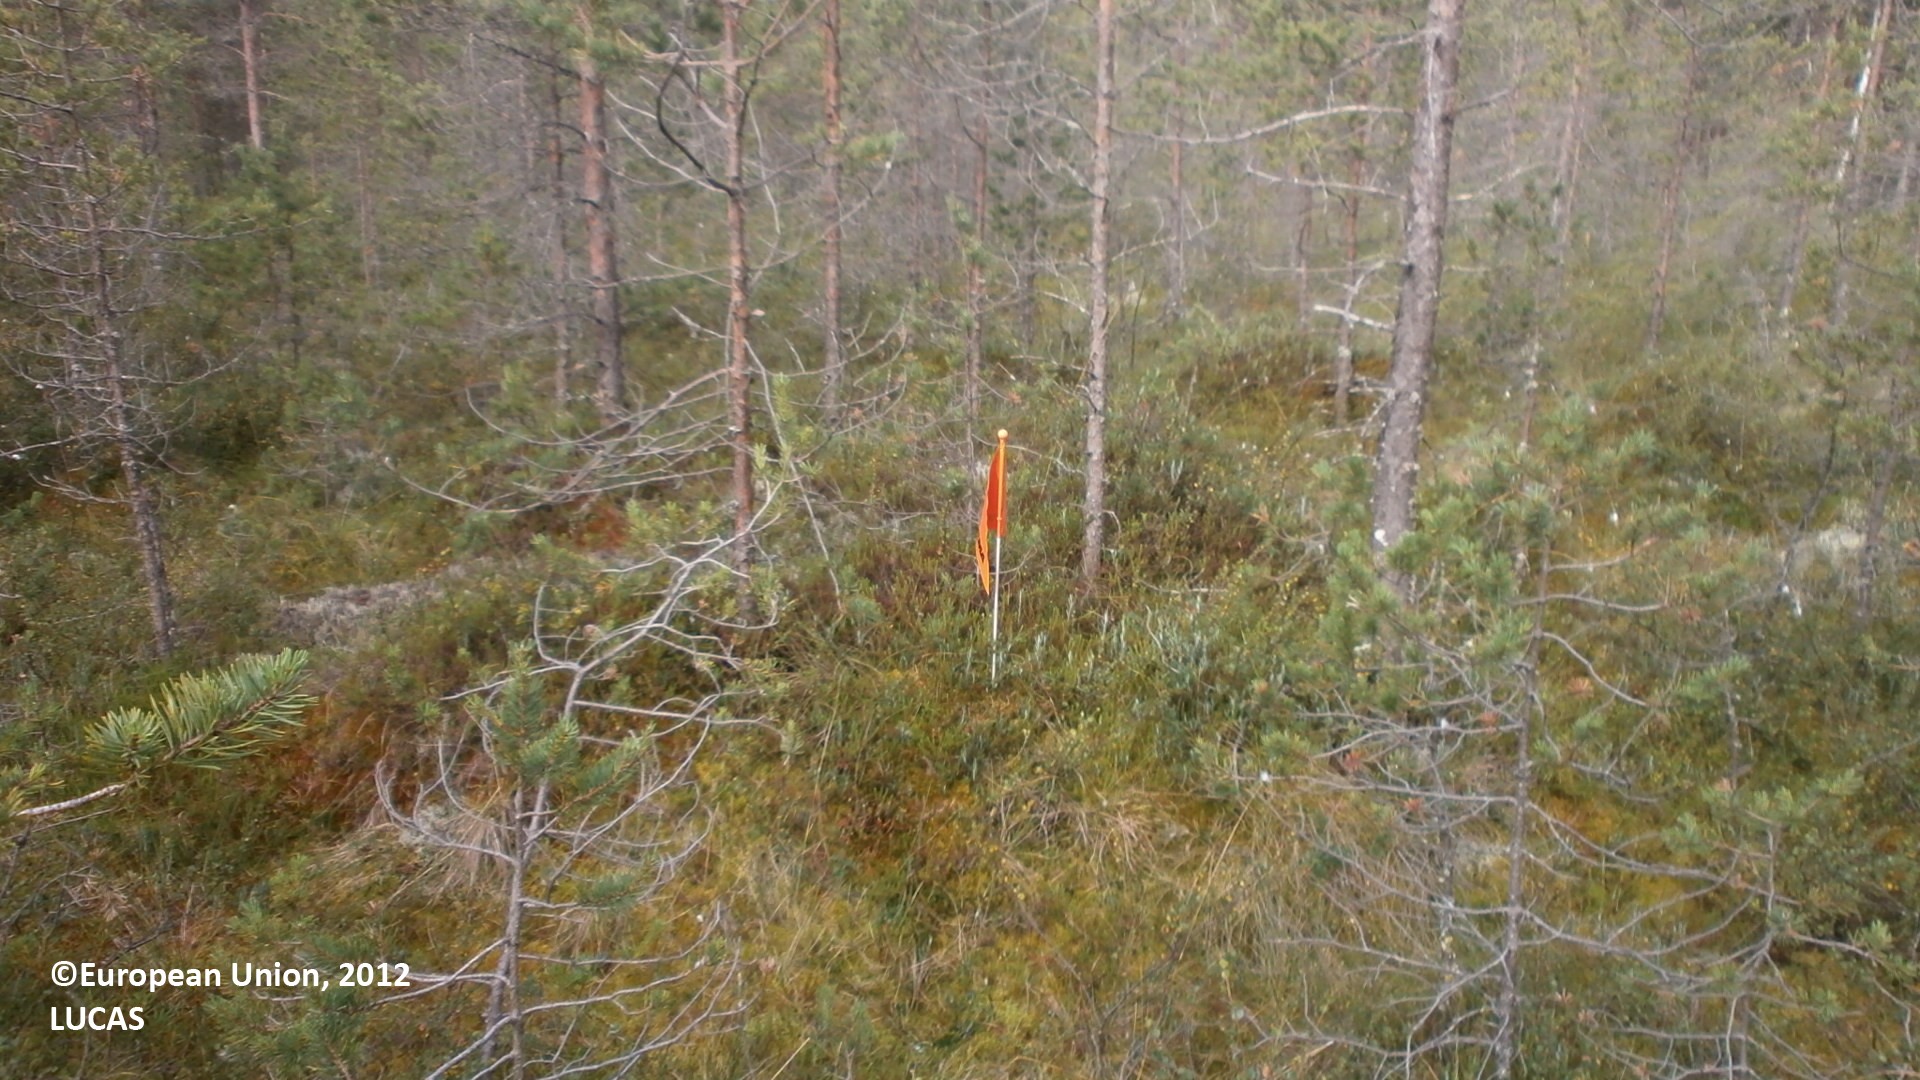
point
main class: Woodland
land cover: Pine dominated coniferous woodland
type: mire and swamp forests
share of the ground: 25 - 50 %
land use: Forestry
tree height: > 5 m
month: July
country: FI
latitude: 64.0696
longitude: 23.9817
